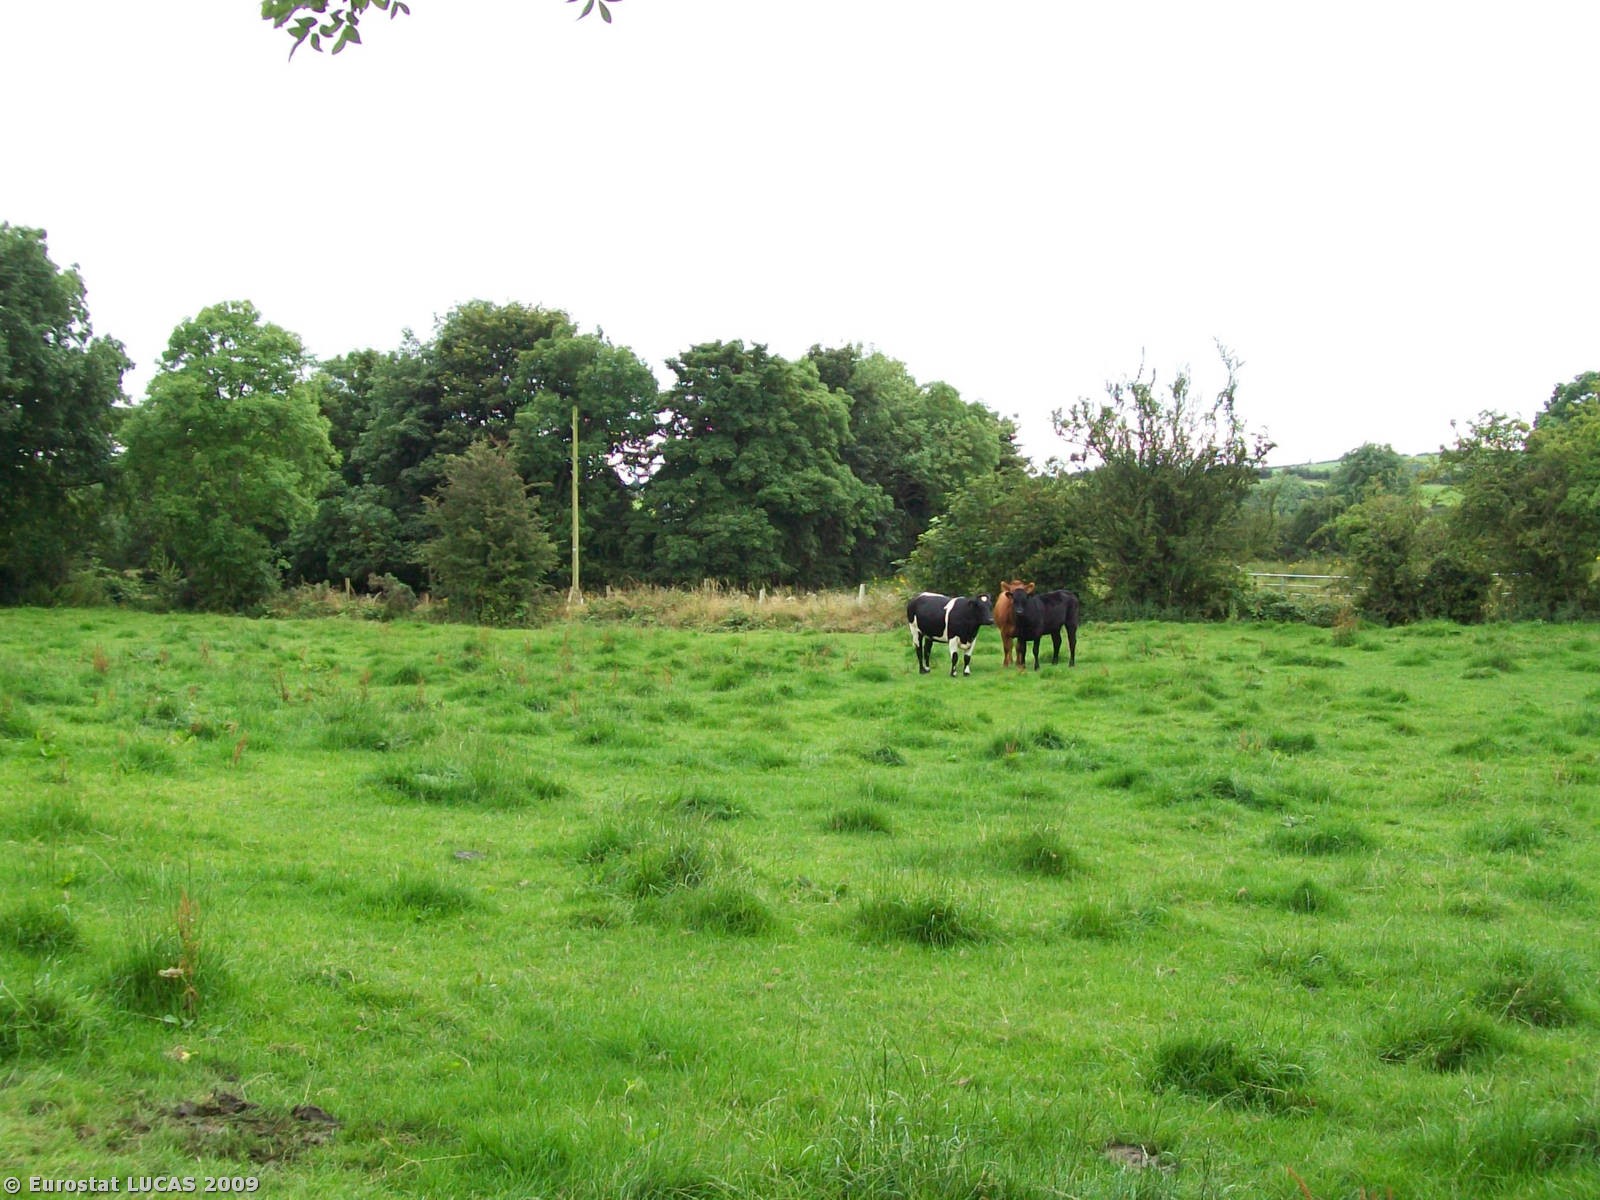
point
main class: Grassland
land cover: Grassland without tree/shrub cover
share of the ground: > 75 %
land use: Agriculture (excluding fallow land and kitchen gardens)
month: August
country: GB
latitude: 54.1364
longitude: -6.6129
